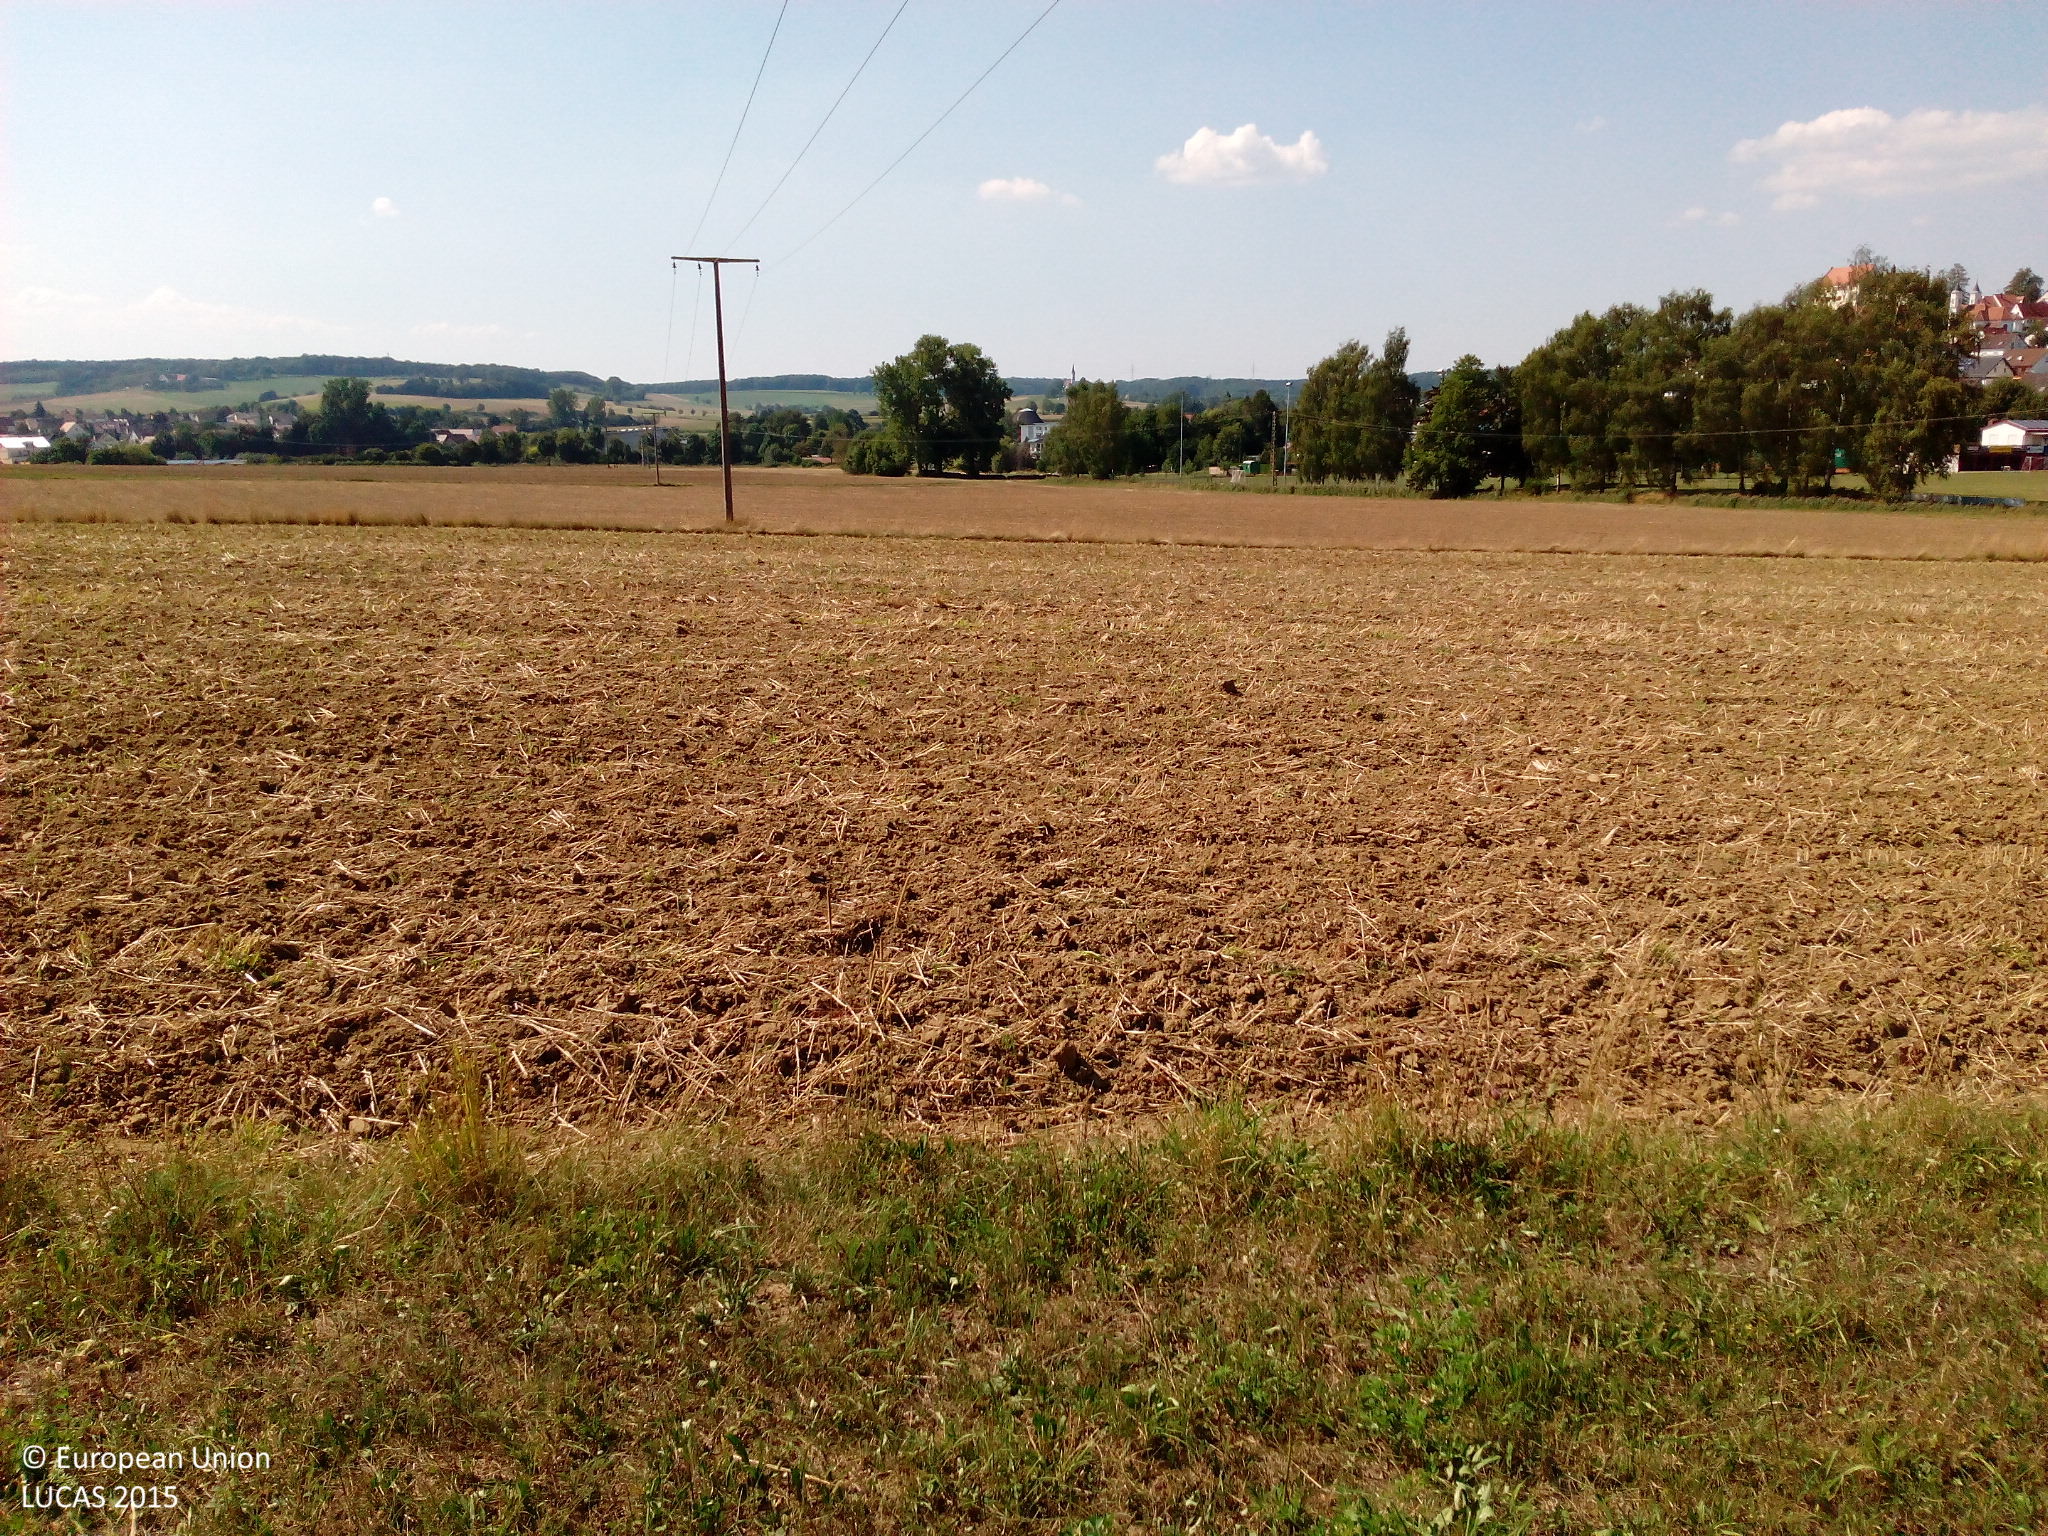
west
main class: Grassland
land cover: Grassland without tree/shrub cover
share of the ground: 50 - 75 %
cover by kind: herbaceous plants 70 %, unconsolidated bare surface 30 %
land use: Agriculture (excluding fallow land and kitchen gardens)
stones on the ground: < 10 %
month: August
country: DE
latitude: 48.6549
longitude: 10.3121
